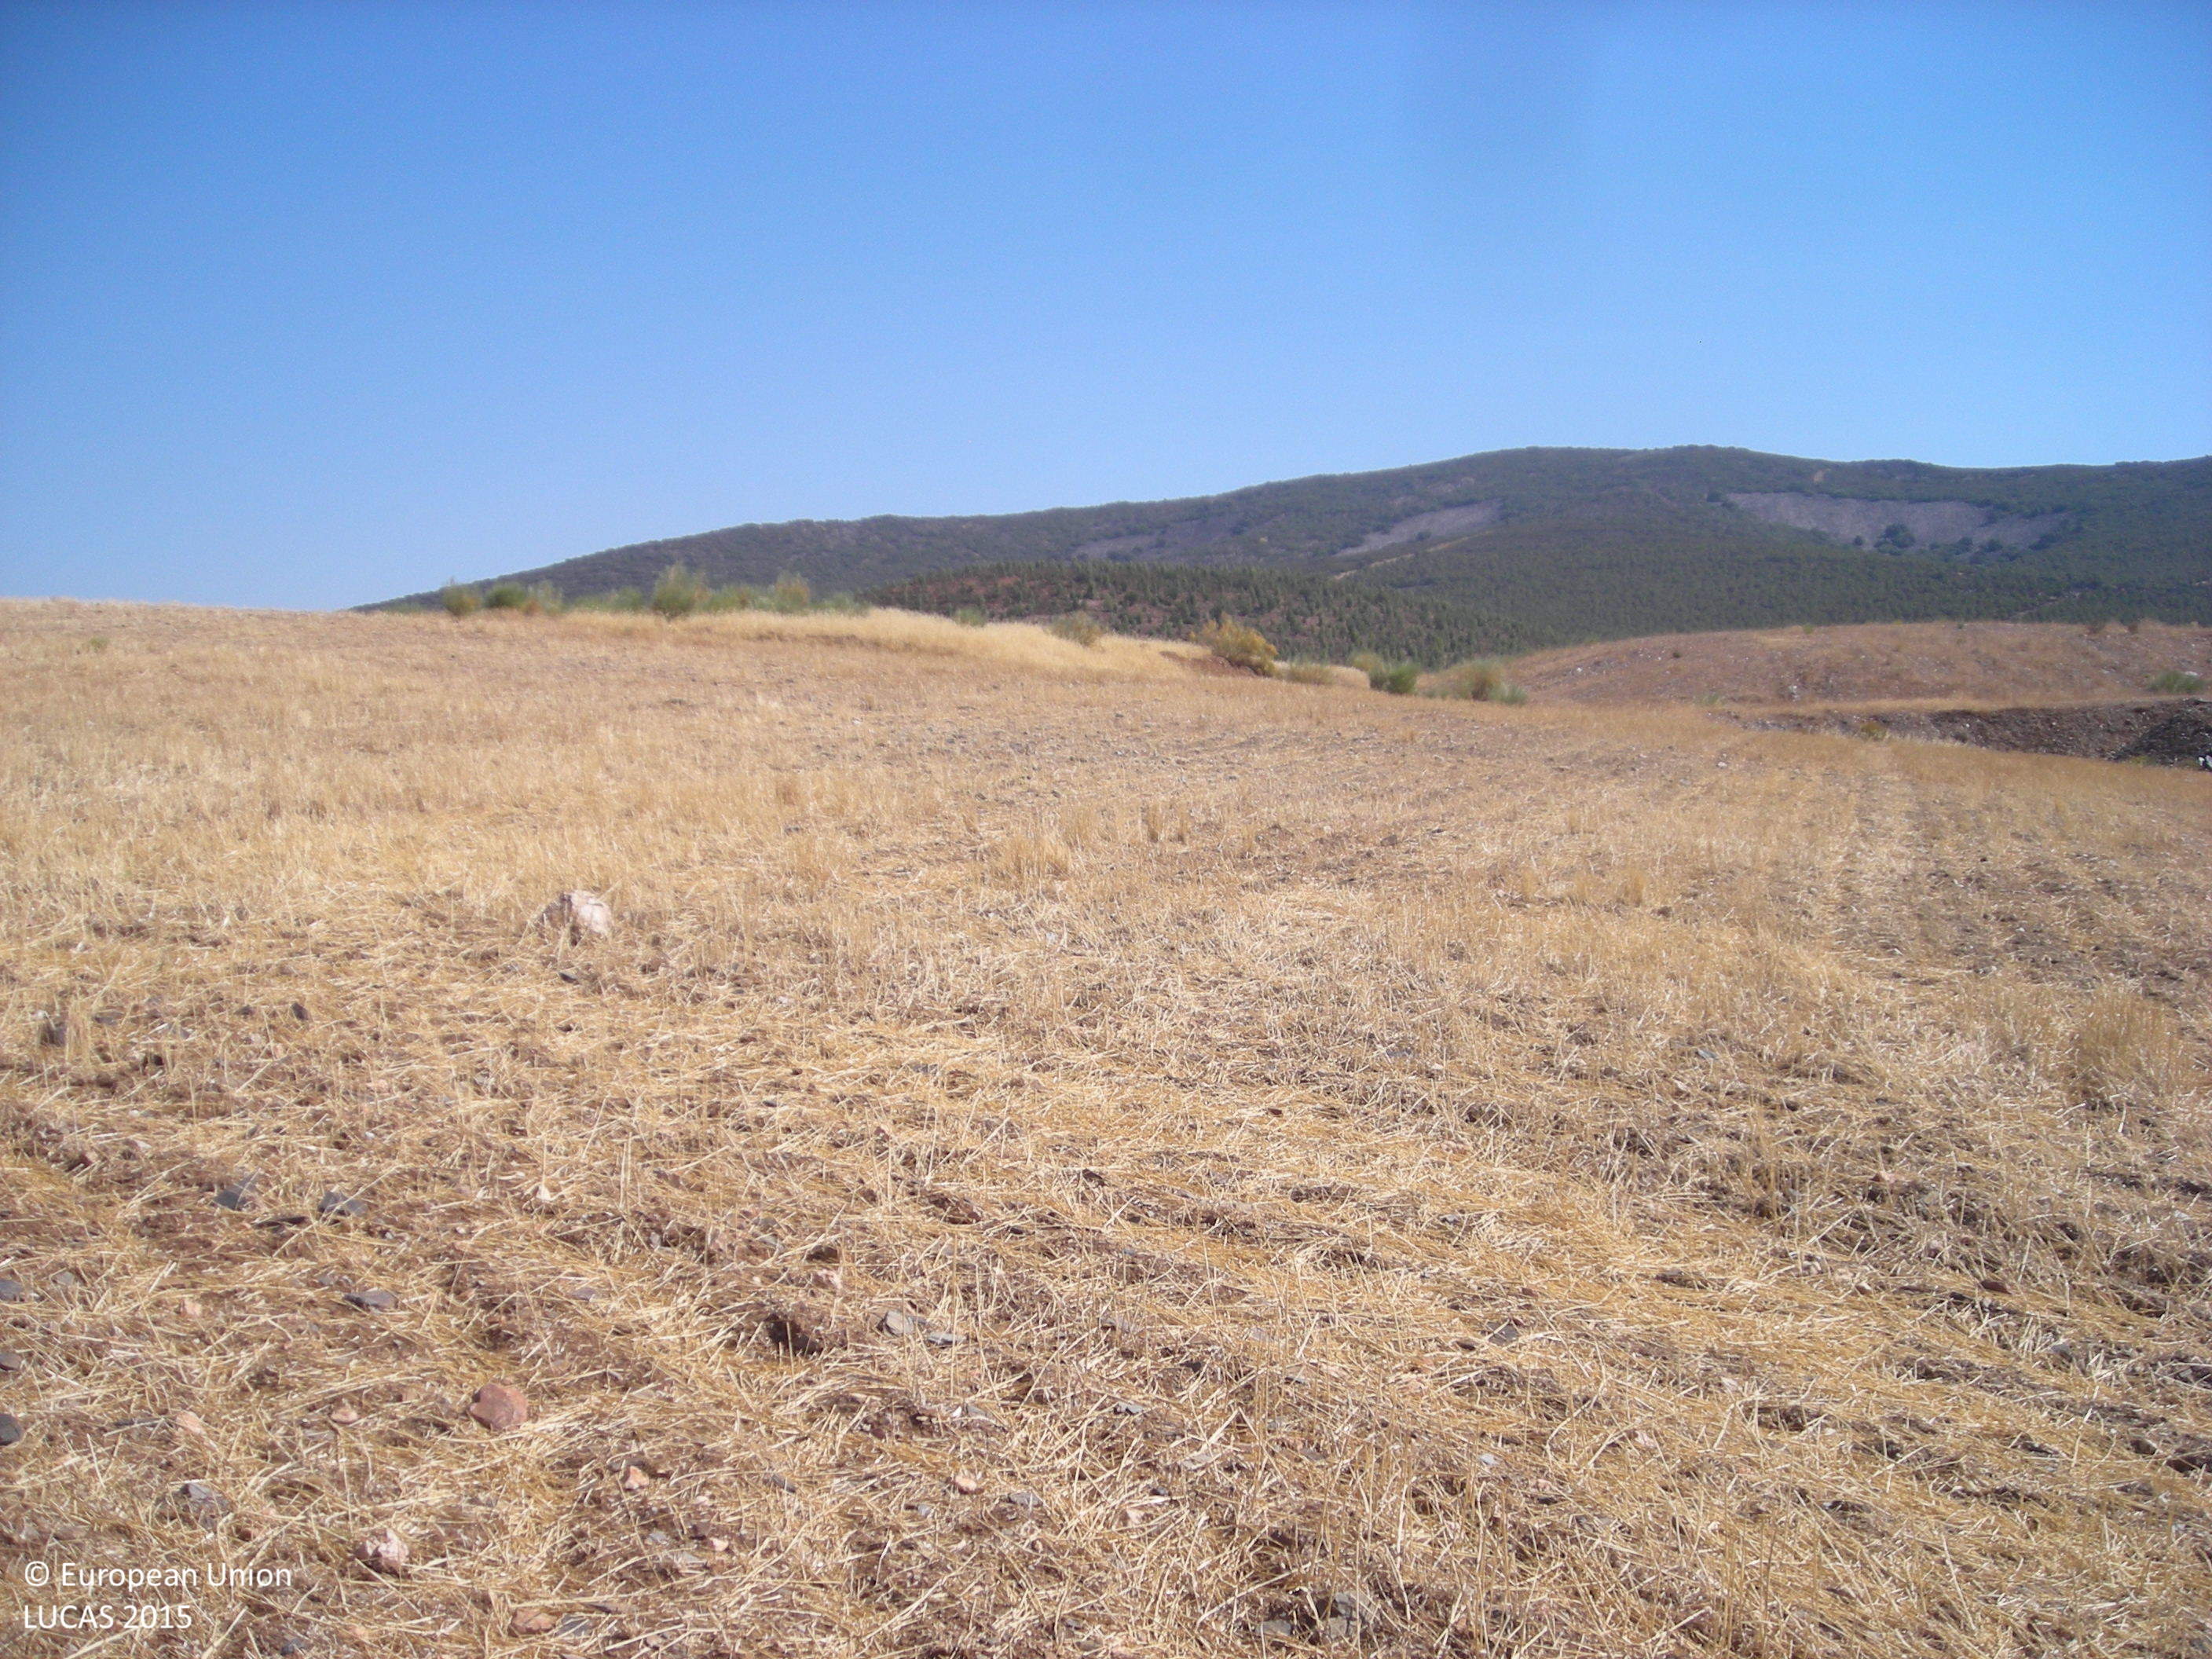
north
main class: Woodland
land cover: Broadleaved woodland
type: broadleaved evergreen forest
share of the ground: > 75 %
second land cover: Grassland without tree/shrub cover
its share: 10 - 25 %
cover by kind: broadleaved forest trees 85 %, herbaceous plants 15 %
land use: Forestry
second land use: Agriculture (excluding fallow land and kitchen gardens)
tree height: > 5 m
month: July
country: ES
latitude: 38.8523
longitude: -5.8919
